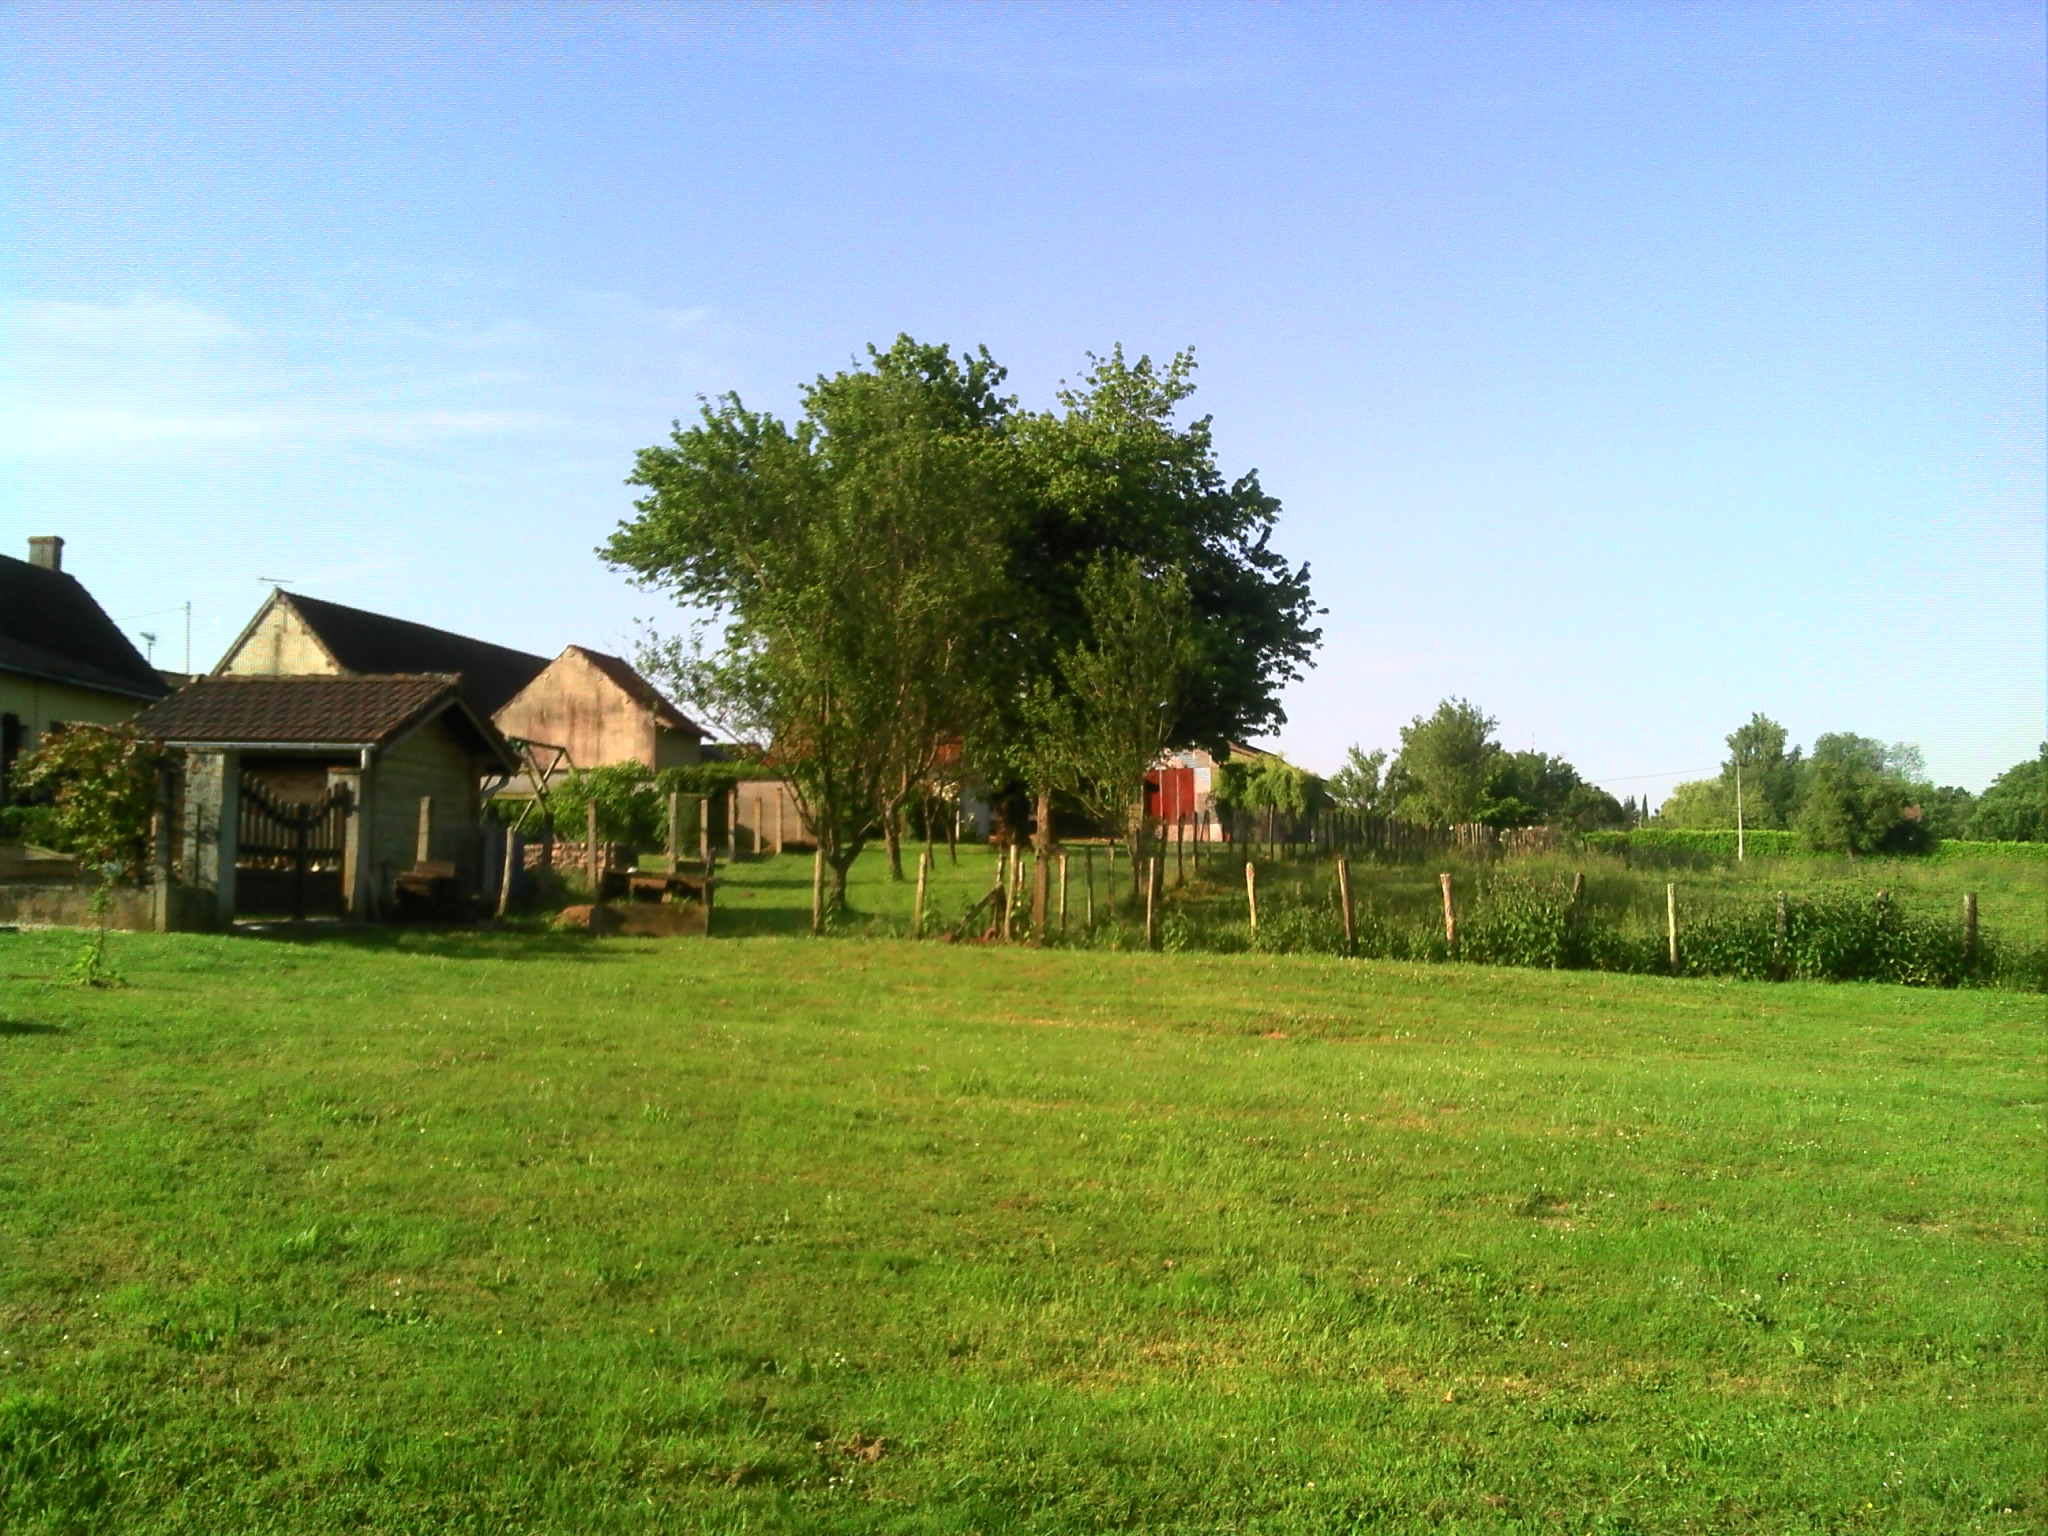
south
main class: Grassland
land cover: Grassland with sparse tree/shrub cover
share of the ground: > 75 %
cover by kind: herbaceous plants 90 %, broadleaved forest trees 5 %, shrubs 5 %
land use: Residential
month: May
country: FR
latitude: 46.5797
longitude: 5.0563
